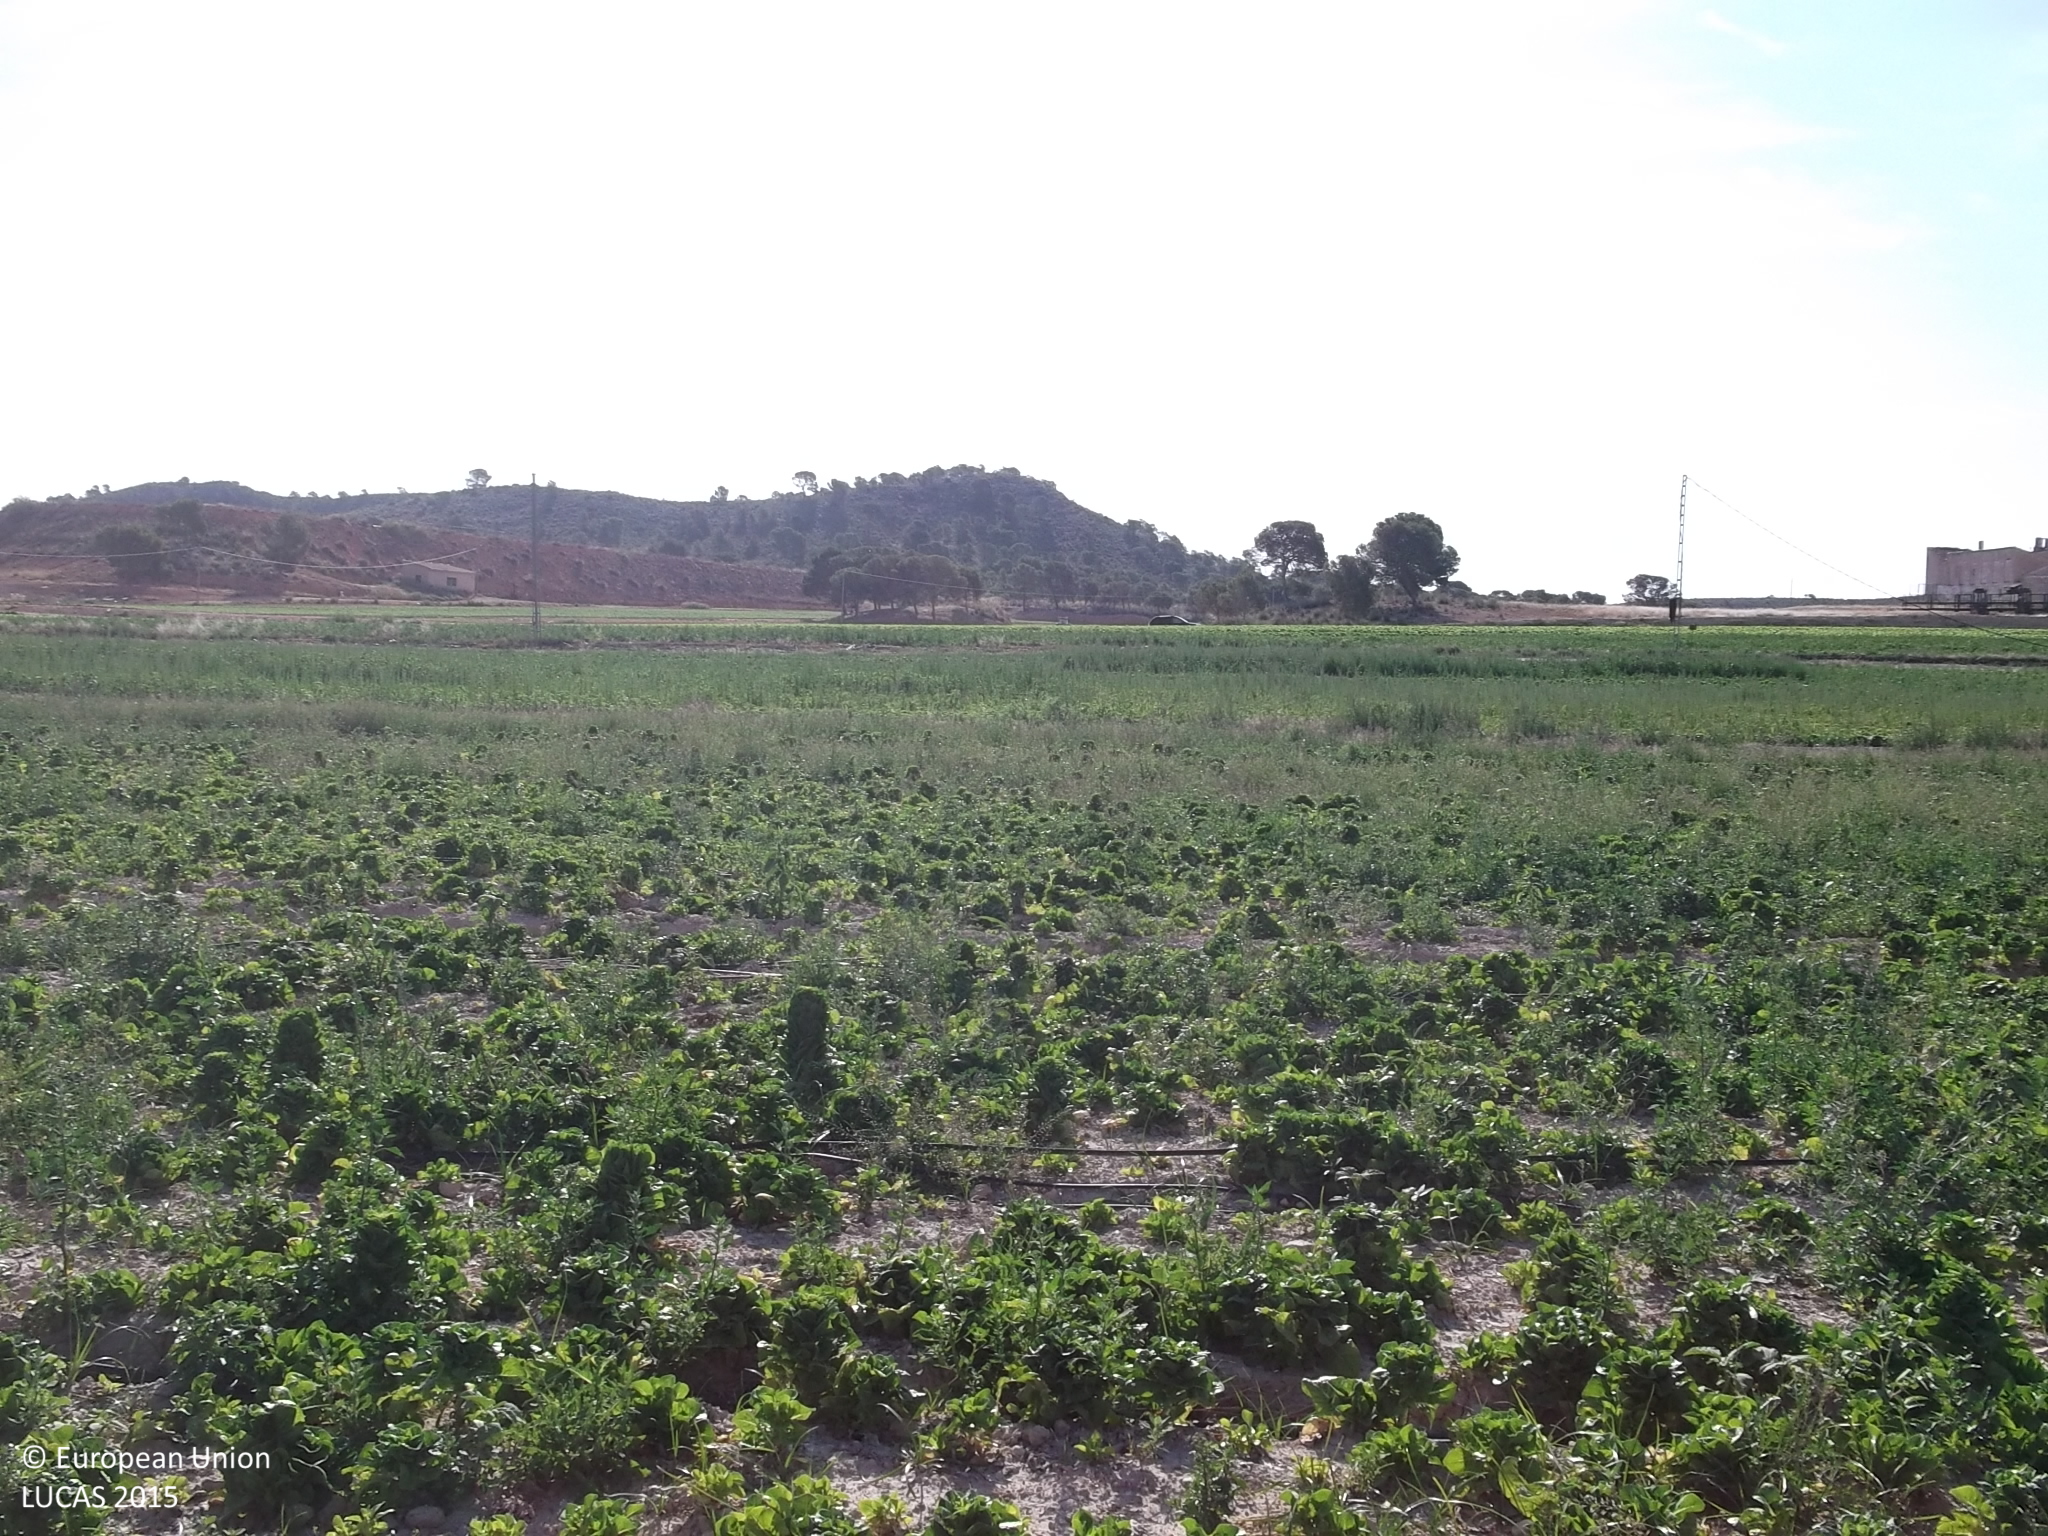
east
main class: Cropland
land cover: Other fresh vegetables
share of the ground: > 75 %
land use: Agriculture (excluding fallow land and kitchen gardens)
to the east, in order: Other fresh vegetables; Grass margins; Tracks; Grass margins; Other fresh vegetables; Tracks; Other fresh vegetables; Electric lines; Other fresh vegetables; Tracks; Spontaneously vegetated surfaces
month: June
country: ES
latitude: 38.4040
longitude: -1.4762
